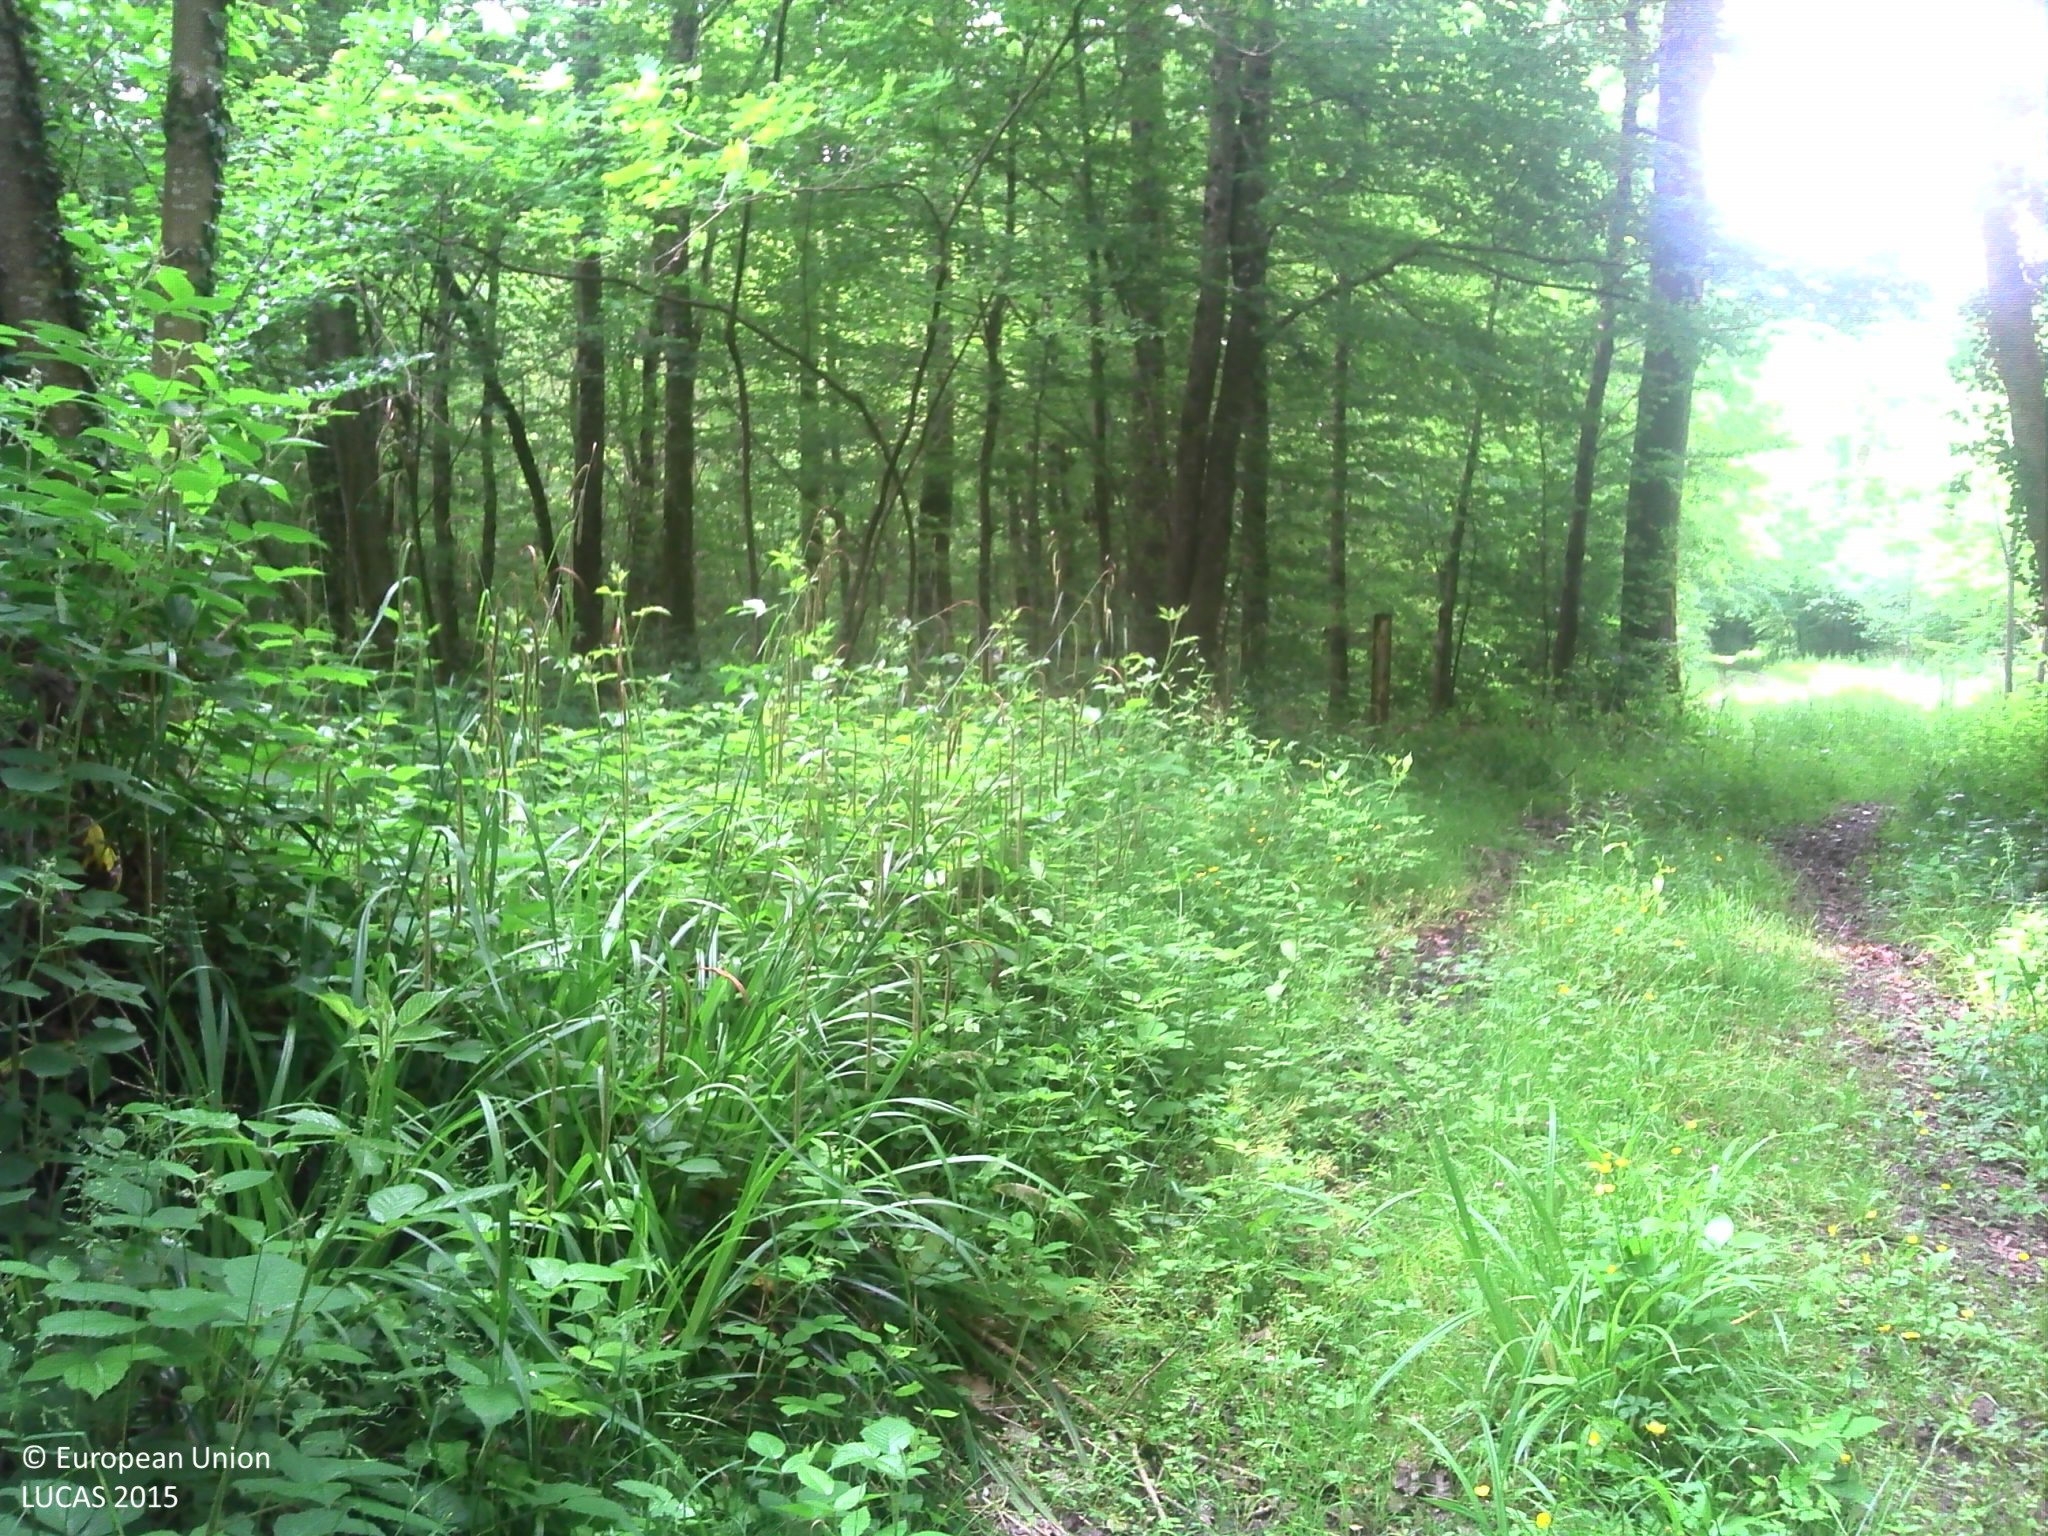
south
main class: Woodland
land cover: Broadleaved woodland
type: mesophytic deciduous forest
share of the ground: > 75 %
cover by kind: broadleaved forest trees 90 %, herbaceous plants 10 %
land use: Forestry
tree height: > 5 m
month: May
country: FR
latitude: 48.6827
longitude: 4.9045
